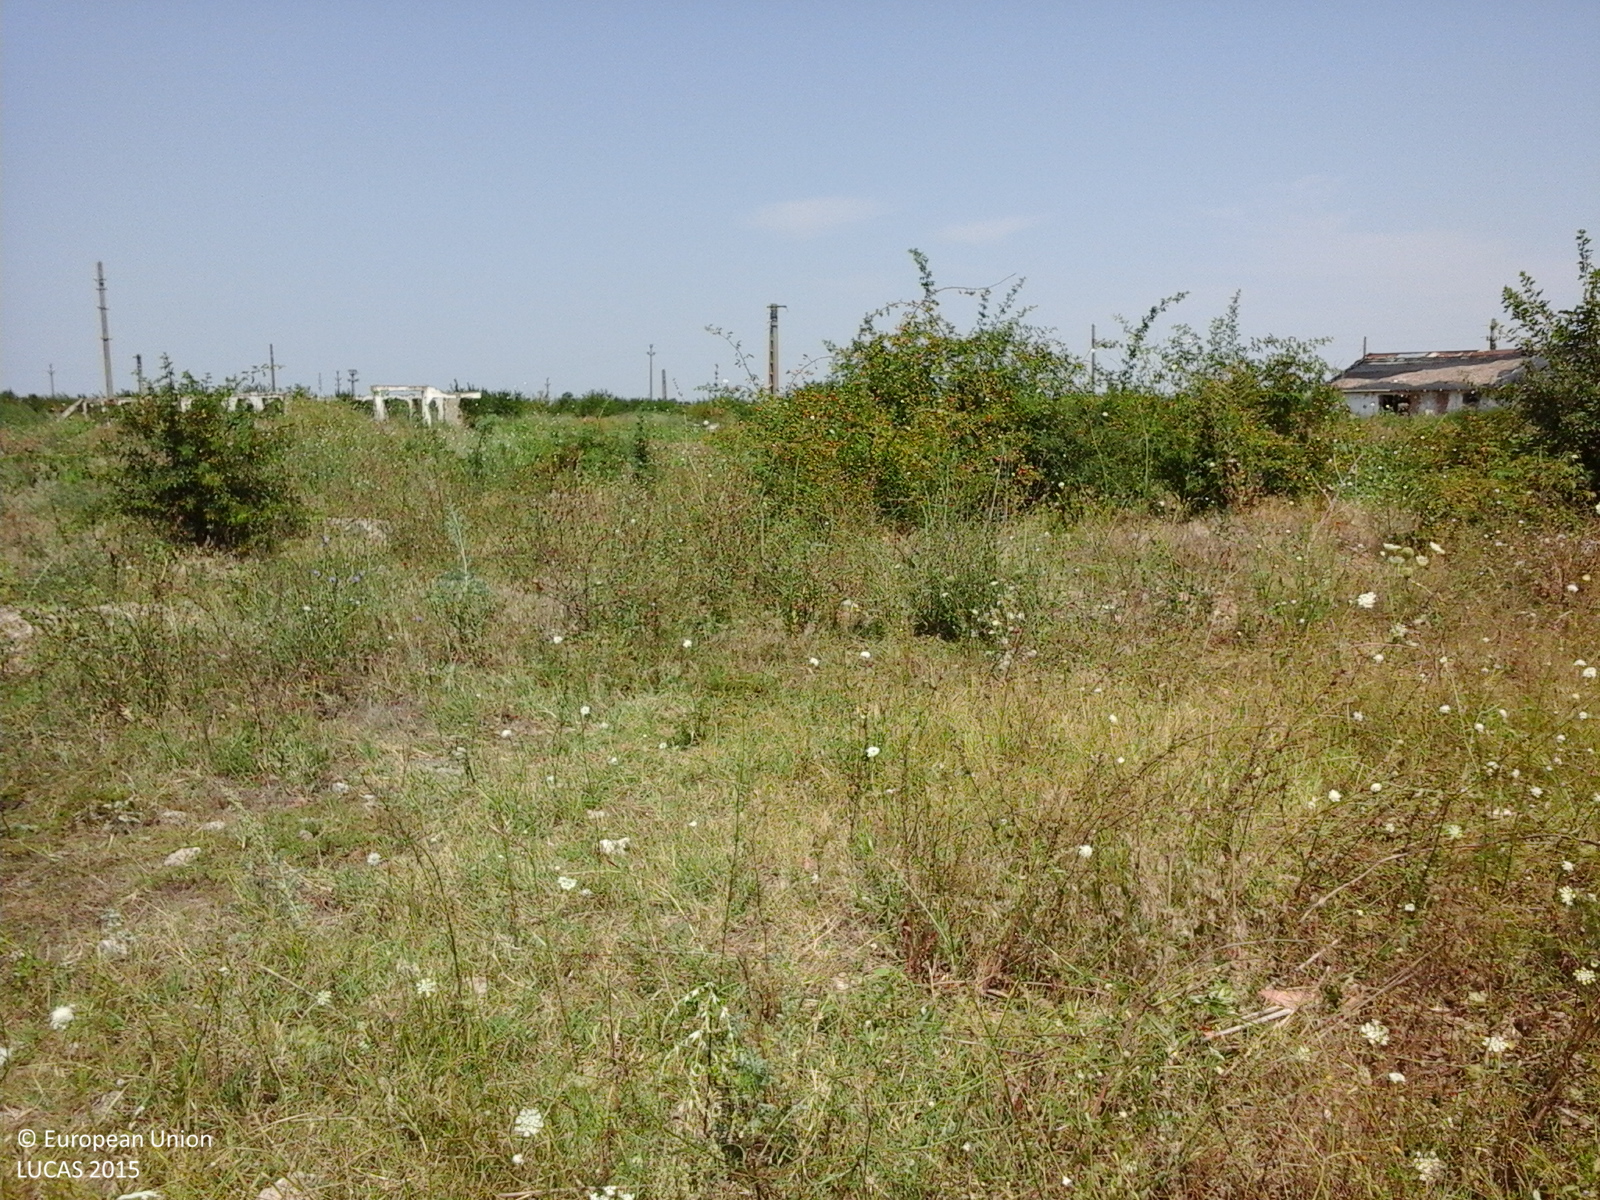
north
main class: Grassland
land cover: Spontaneously vegetated surfaces
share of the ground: > 75 %
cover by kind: herbaceous plants 100 %
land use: Fallow land
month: August
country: RO
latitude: 45.5289
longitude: 27.5564
